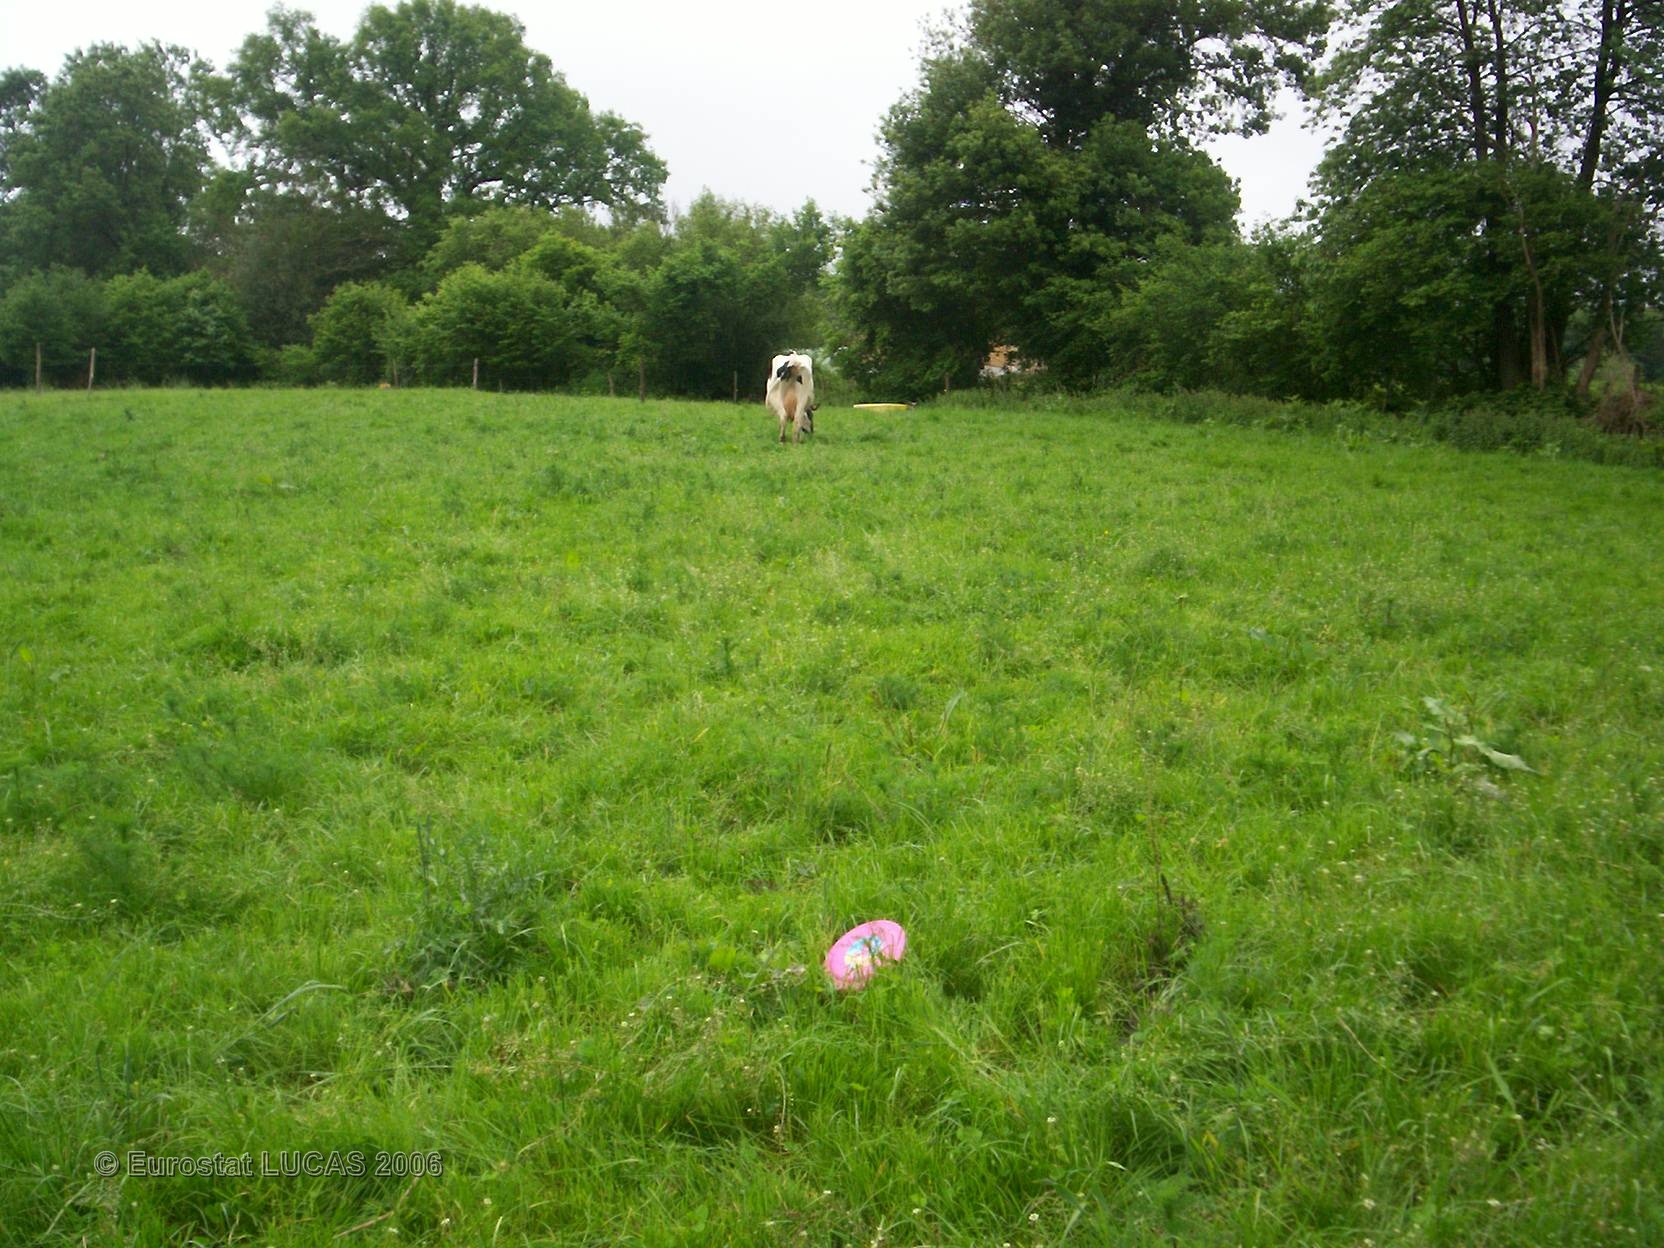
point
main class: Grassland
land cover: Grassland without tree/shrub cover
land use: Agriculture (excluding fallow land and kitchen gardens)
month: May
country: FR
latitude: 48.4300
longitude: 0.3103
